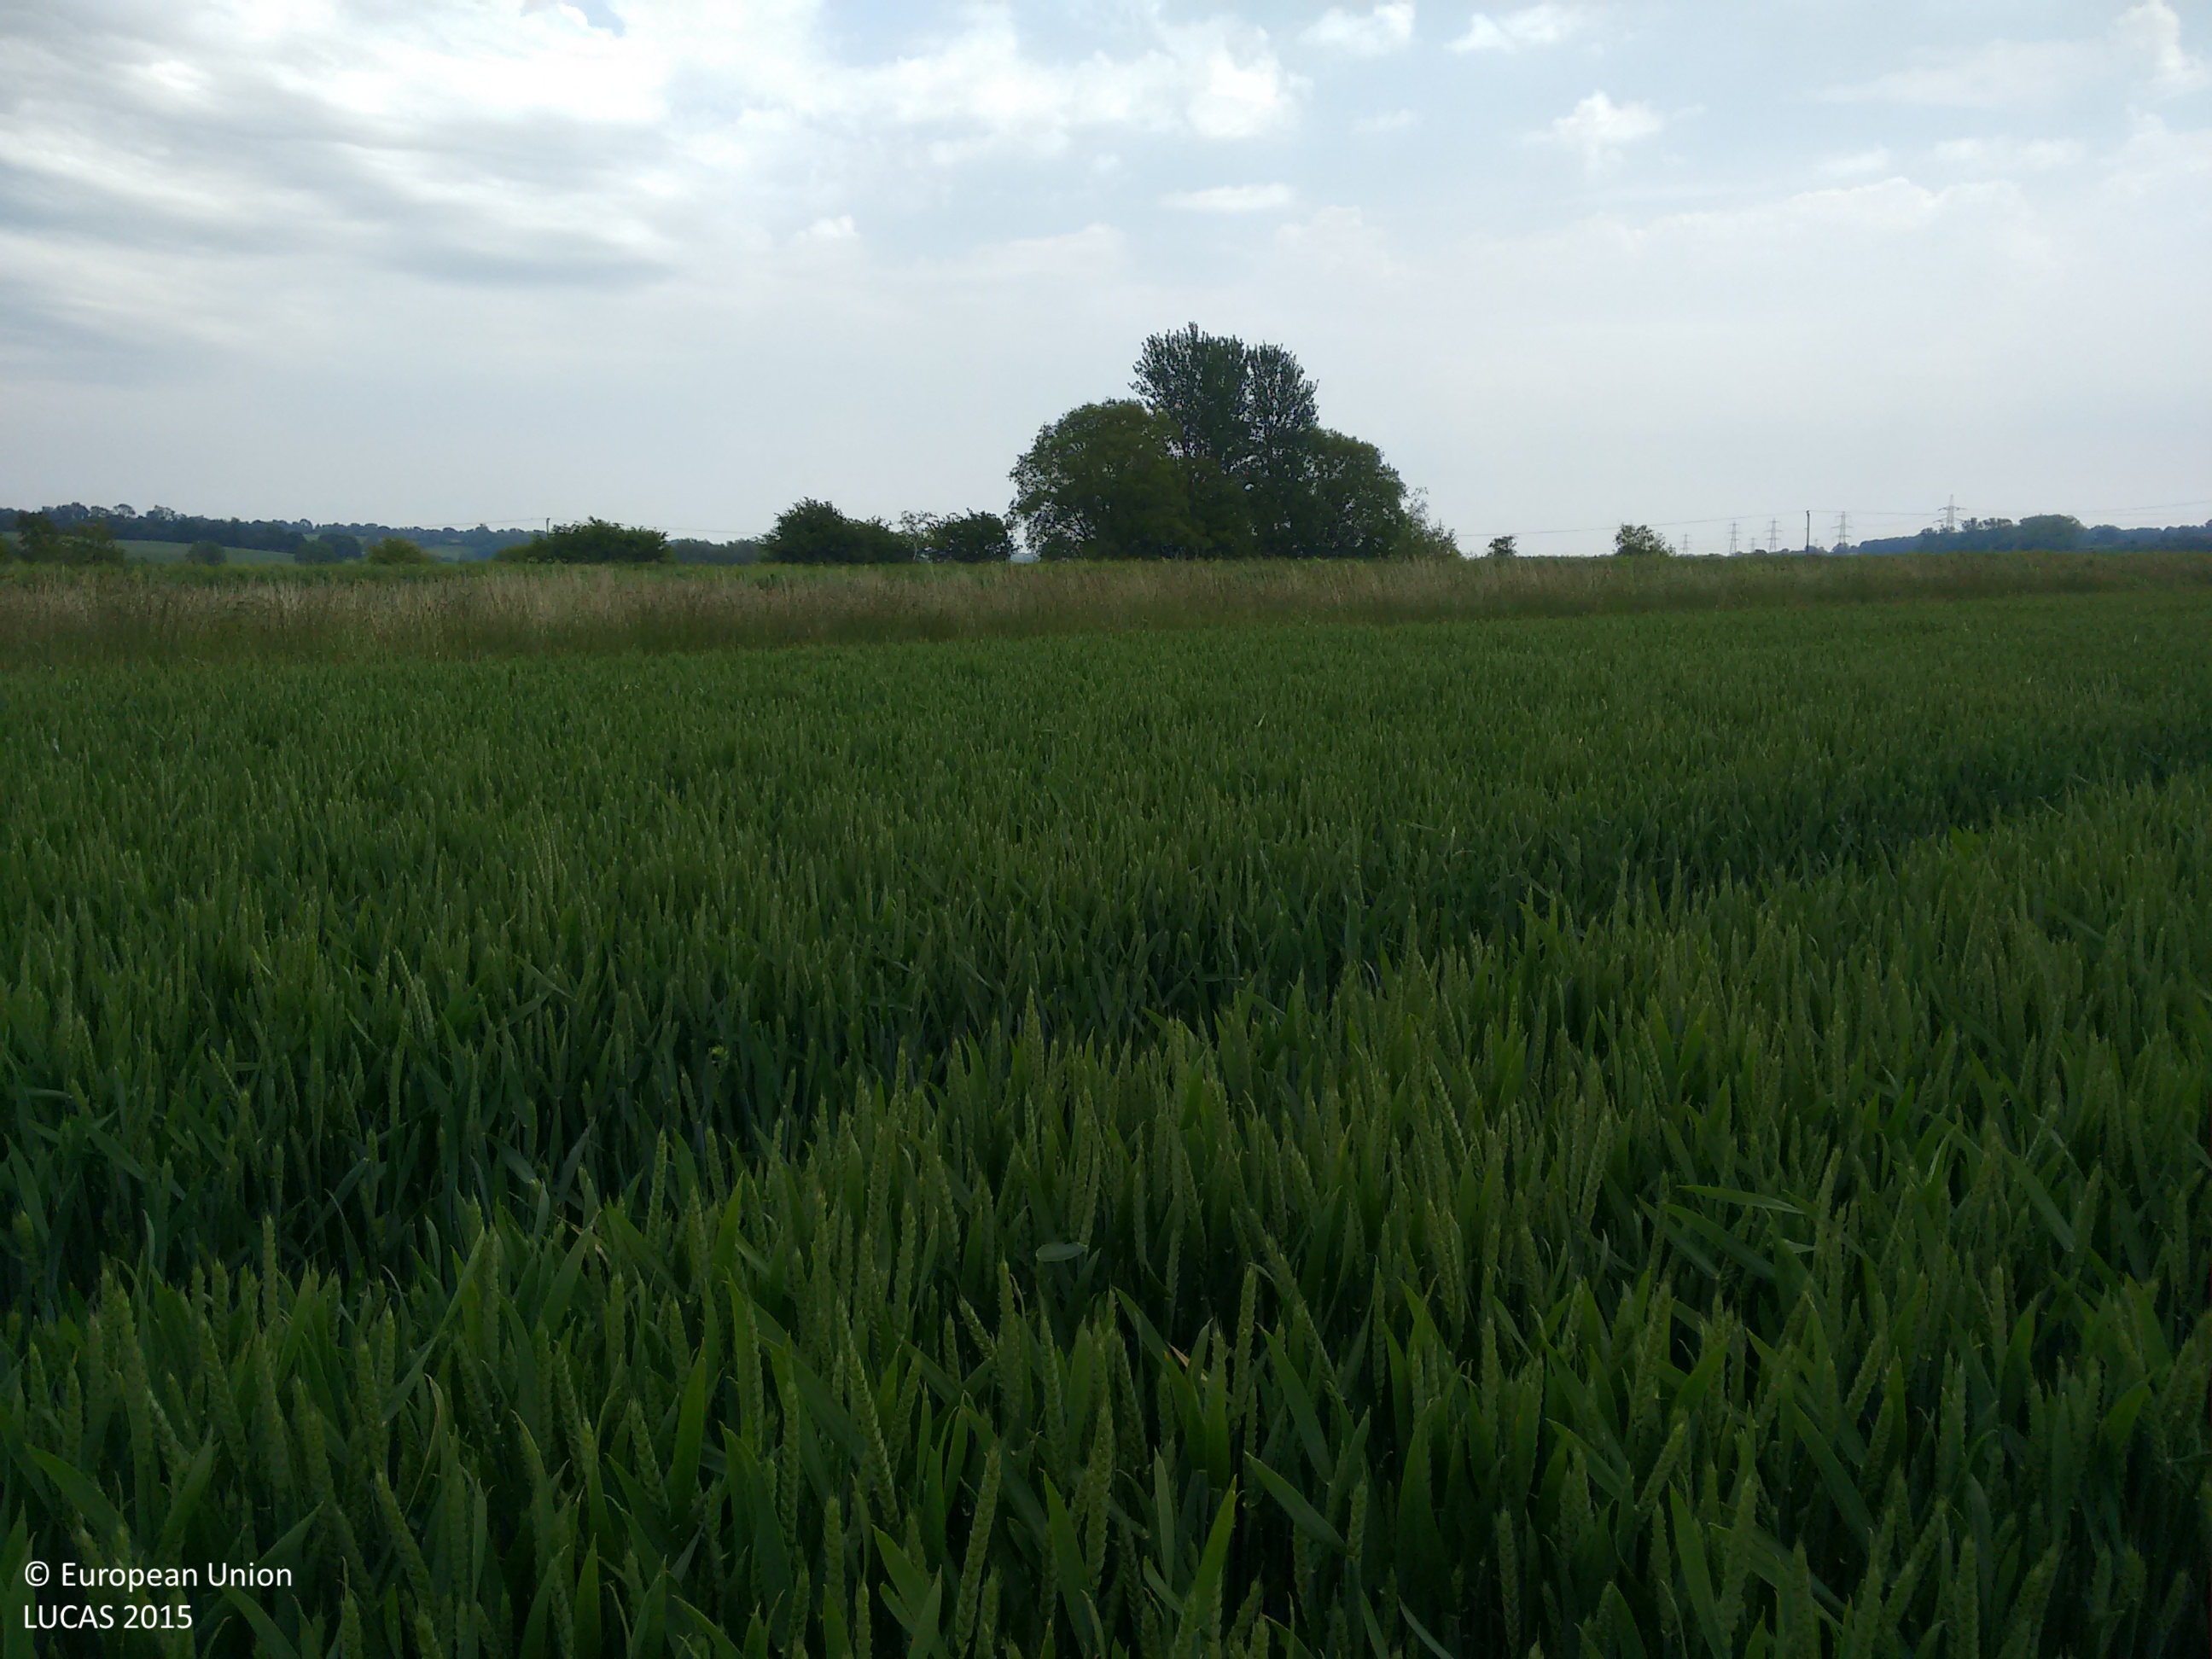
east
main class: Cropland
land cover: Common wheat
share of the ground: > 75 %
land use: Agriculture (excluding fallow land and kitchen gardens)
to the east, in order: Common wheat; Grassland without tree/shrub cover; Tracks; Grassland without tree/shrub cover; Inland fresh running water; Grassland without tree/shrub cover; Tracks; Grassland without tree/shrub cover
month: June
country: GB
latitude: 50.9980
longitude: 0.6979
